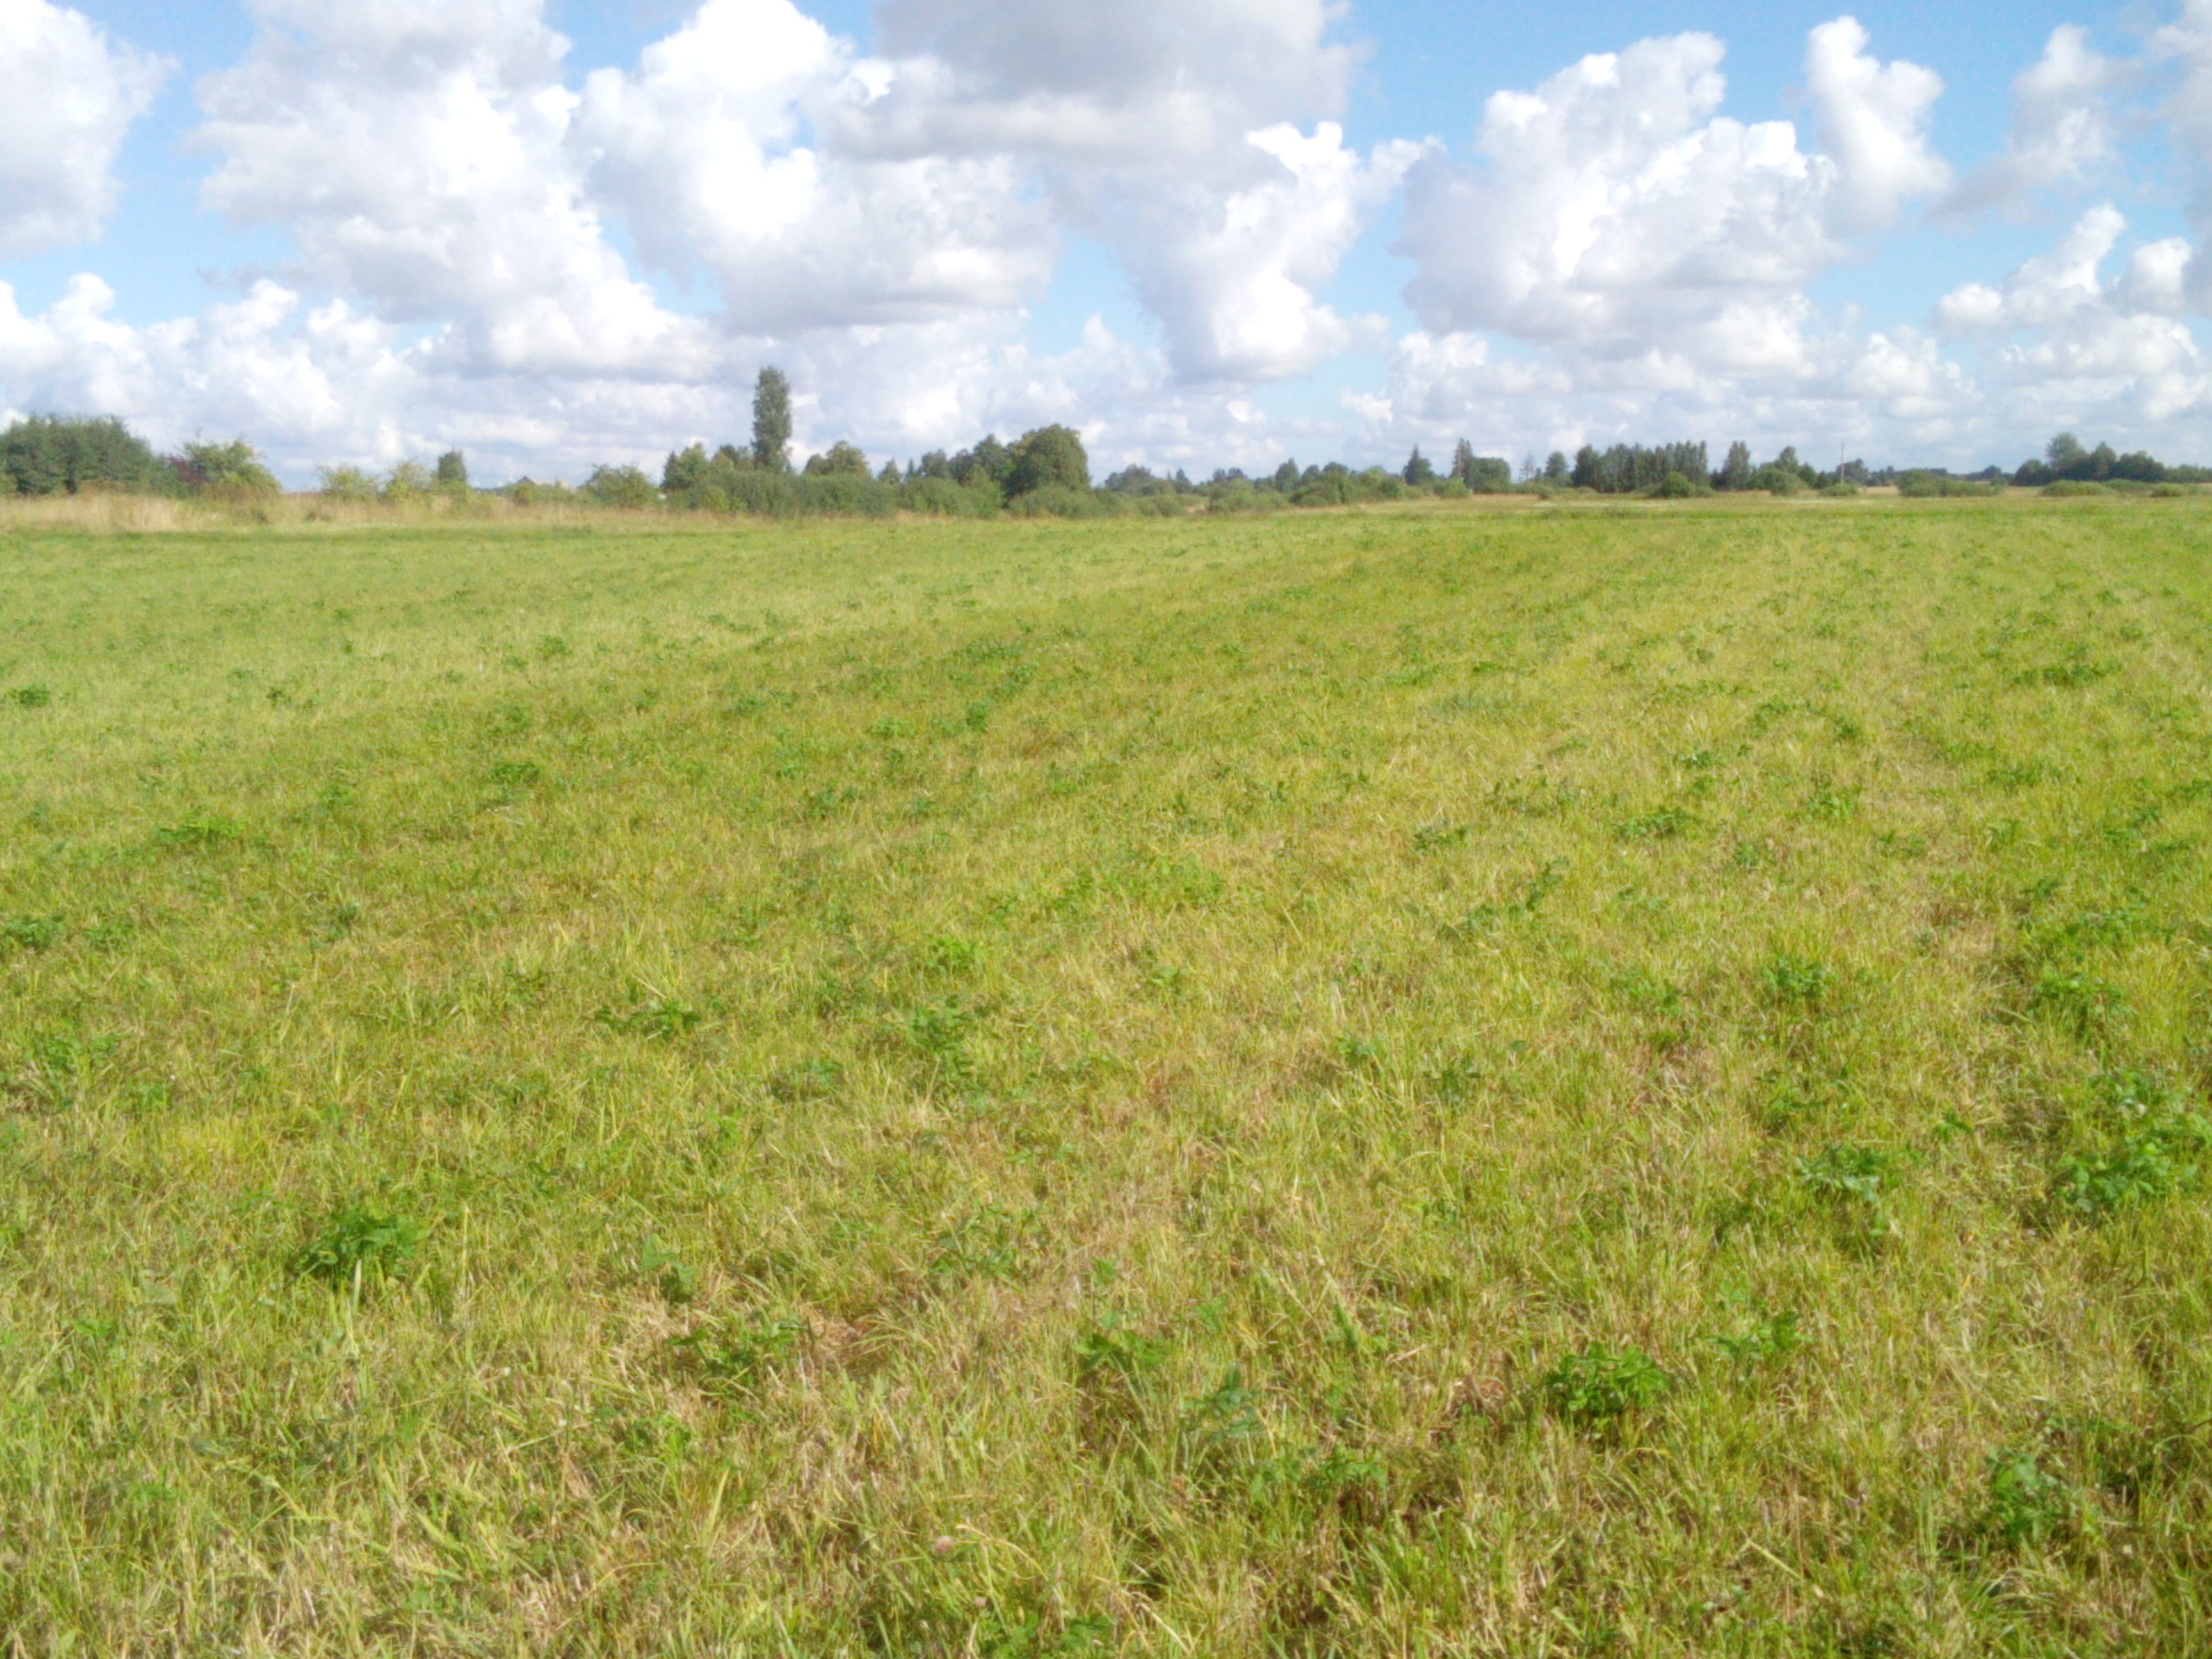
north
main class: Grassland
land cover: Grassland without tree/shrub cover
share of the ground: > 75 %
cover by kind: herbaceous plants 100 %
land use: Agriculture (excluding fallow land and kitchen gardens)
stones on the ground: < 10 %
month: August
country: LV
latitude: 56.4900
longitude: 21.2616
